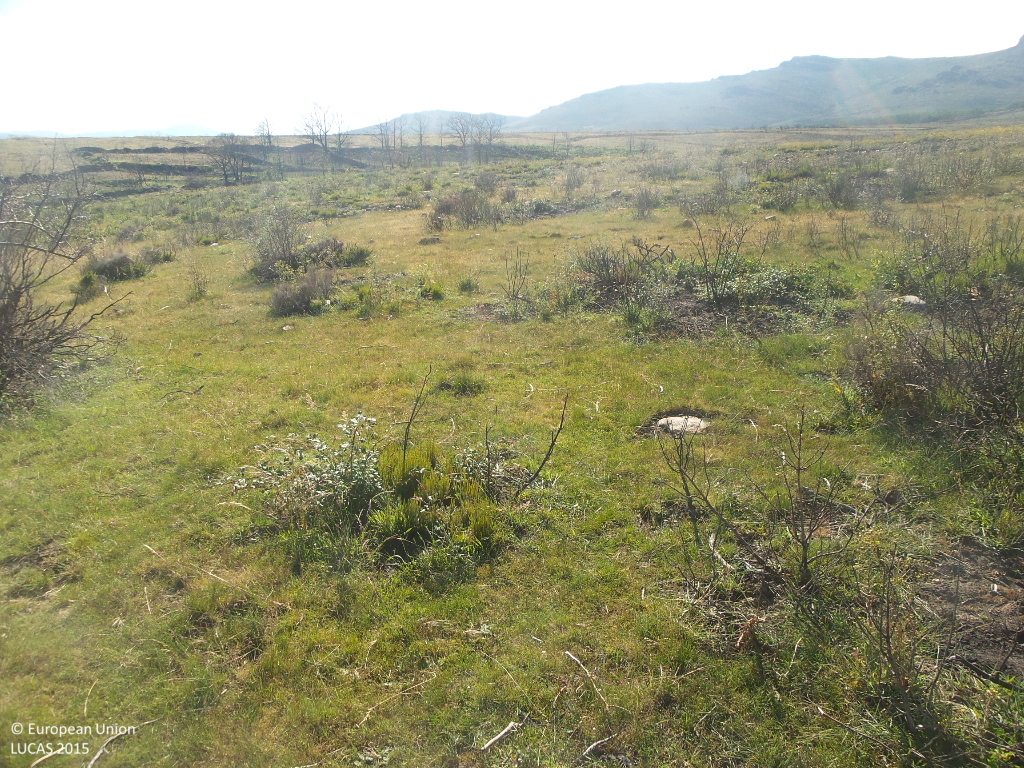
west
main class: Shrubland
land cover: Shrubland without tree cover
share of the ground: 25 - 50 %
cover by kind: herbaceous plants 50 %, shrubs 30 %, unconsolidated bare surface 20 %
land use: Semi-natural and natural areas not in use
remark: Burnt area
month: June
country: ES
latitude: 41.1494
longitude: -3.0377
